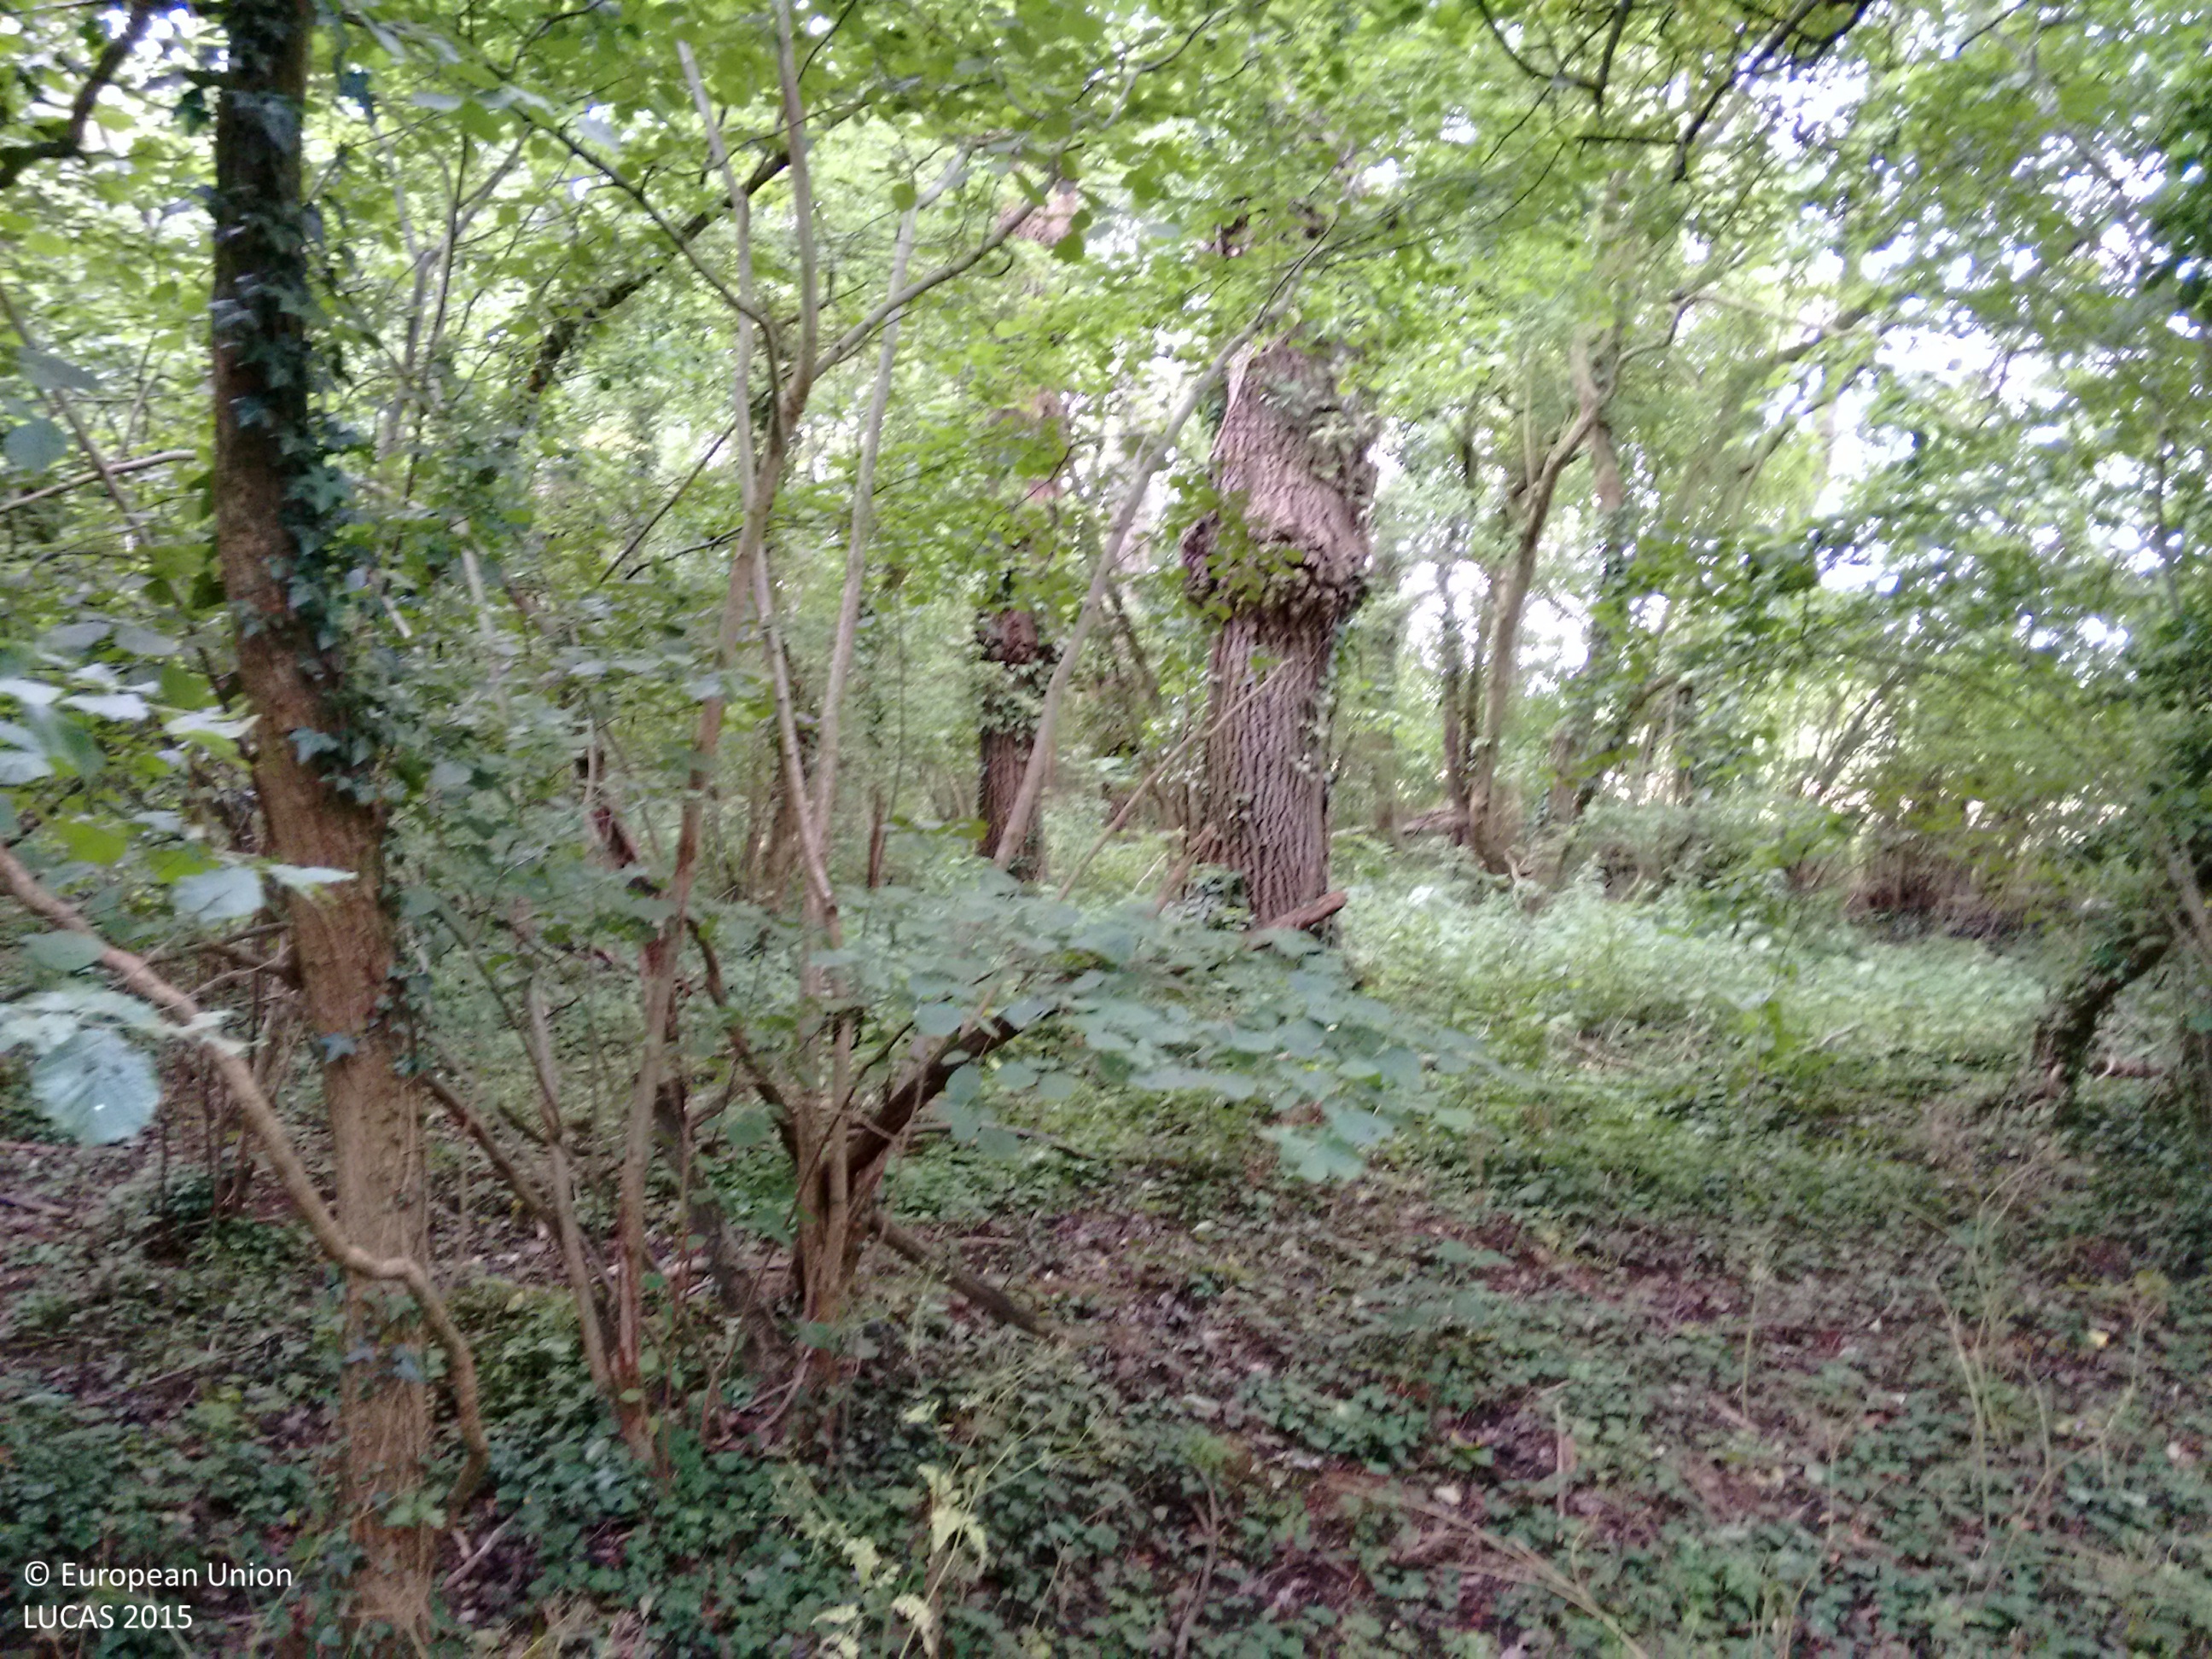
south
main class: Woodland
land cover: Broadleaved woodland
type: mesophytic deciduous forest
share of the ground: > 75 %
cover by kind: broadleaved forest trees 90 %, herbaceous plants 10 %
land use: Semi-natural and natural areas not in use
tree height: > 5 m
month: July
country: GB
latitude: 51.7317
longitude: -1.6218
